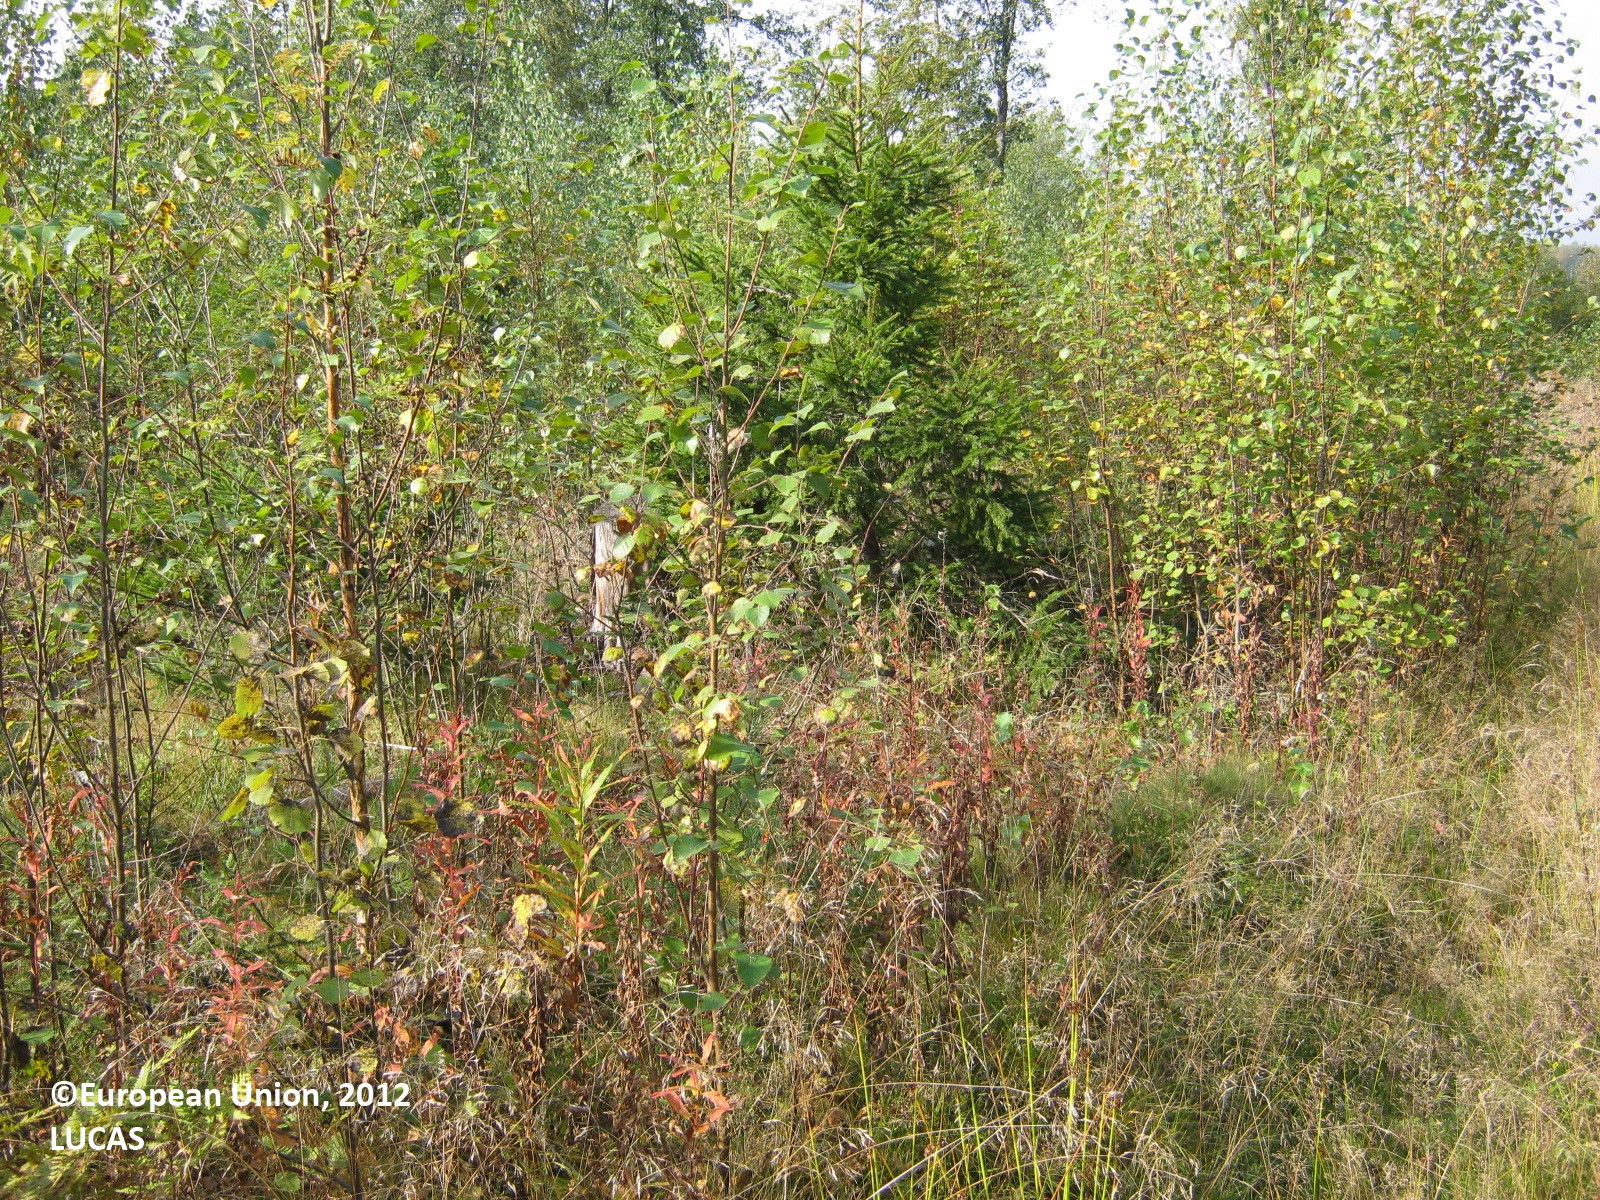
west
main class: Woodland
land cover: Broadleaved woodland
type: boreal forest
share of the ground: 25 - 50 %
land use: Forestry
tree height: < 5 m
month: September
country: FI
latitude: 60.5285
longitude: 27.7039
